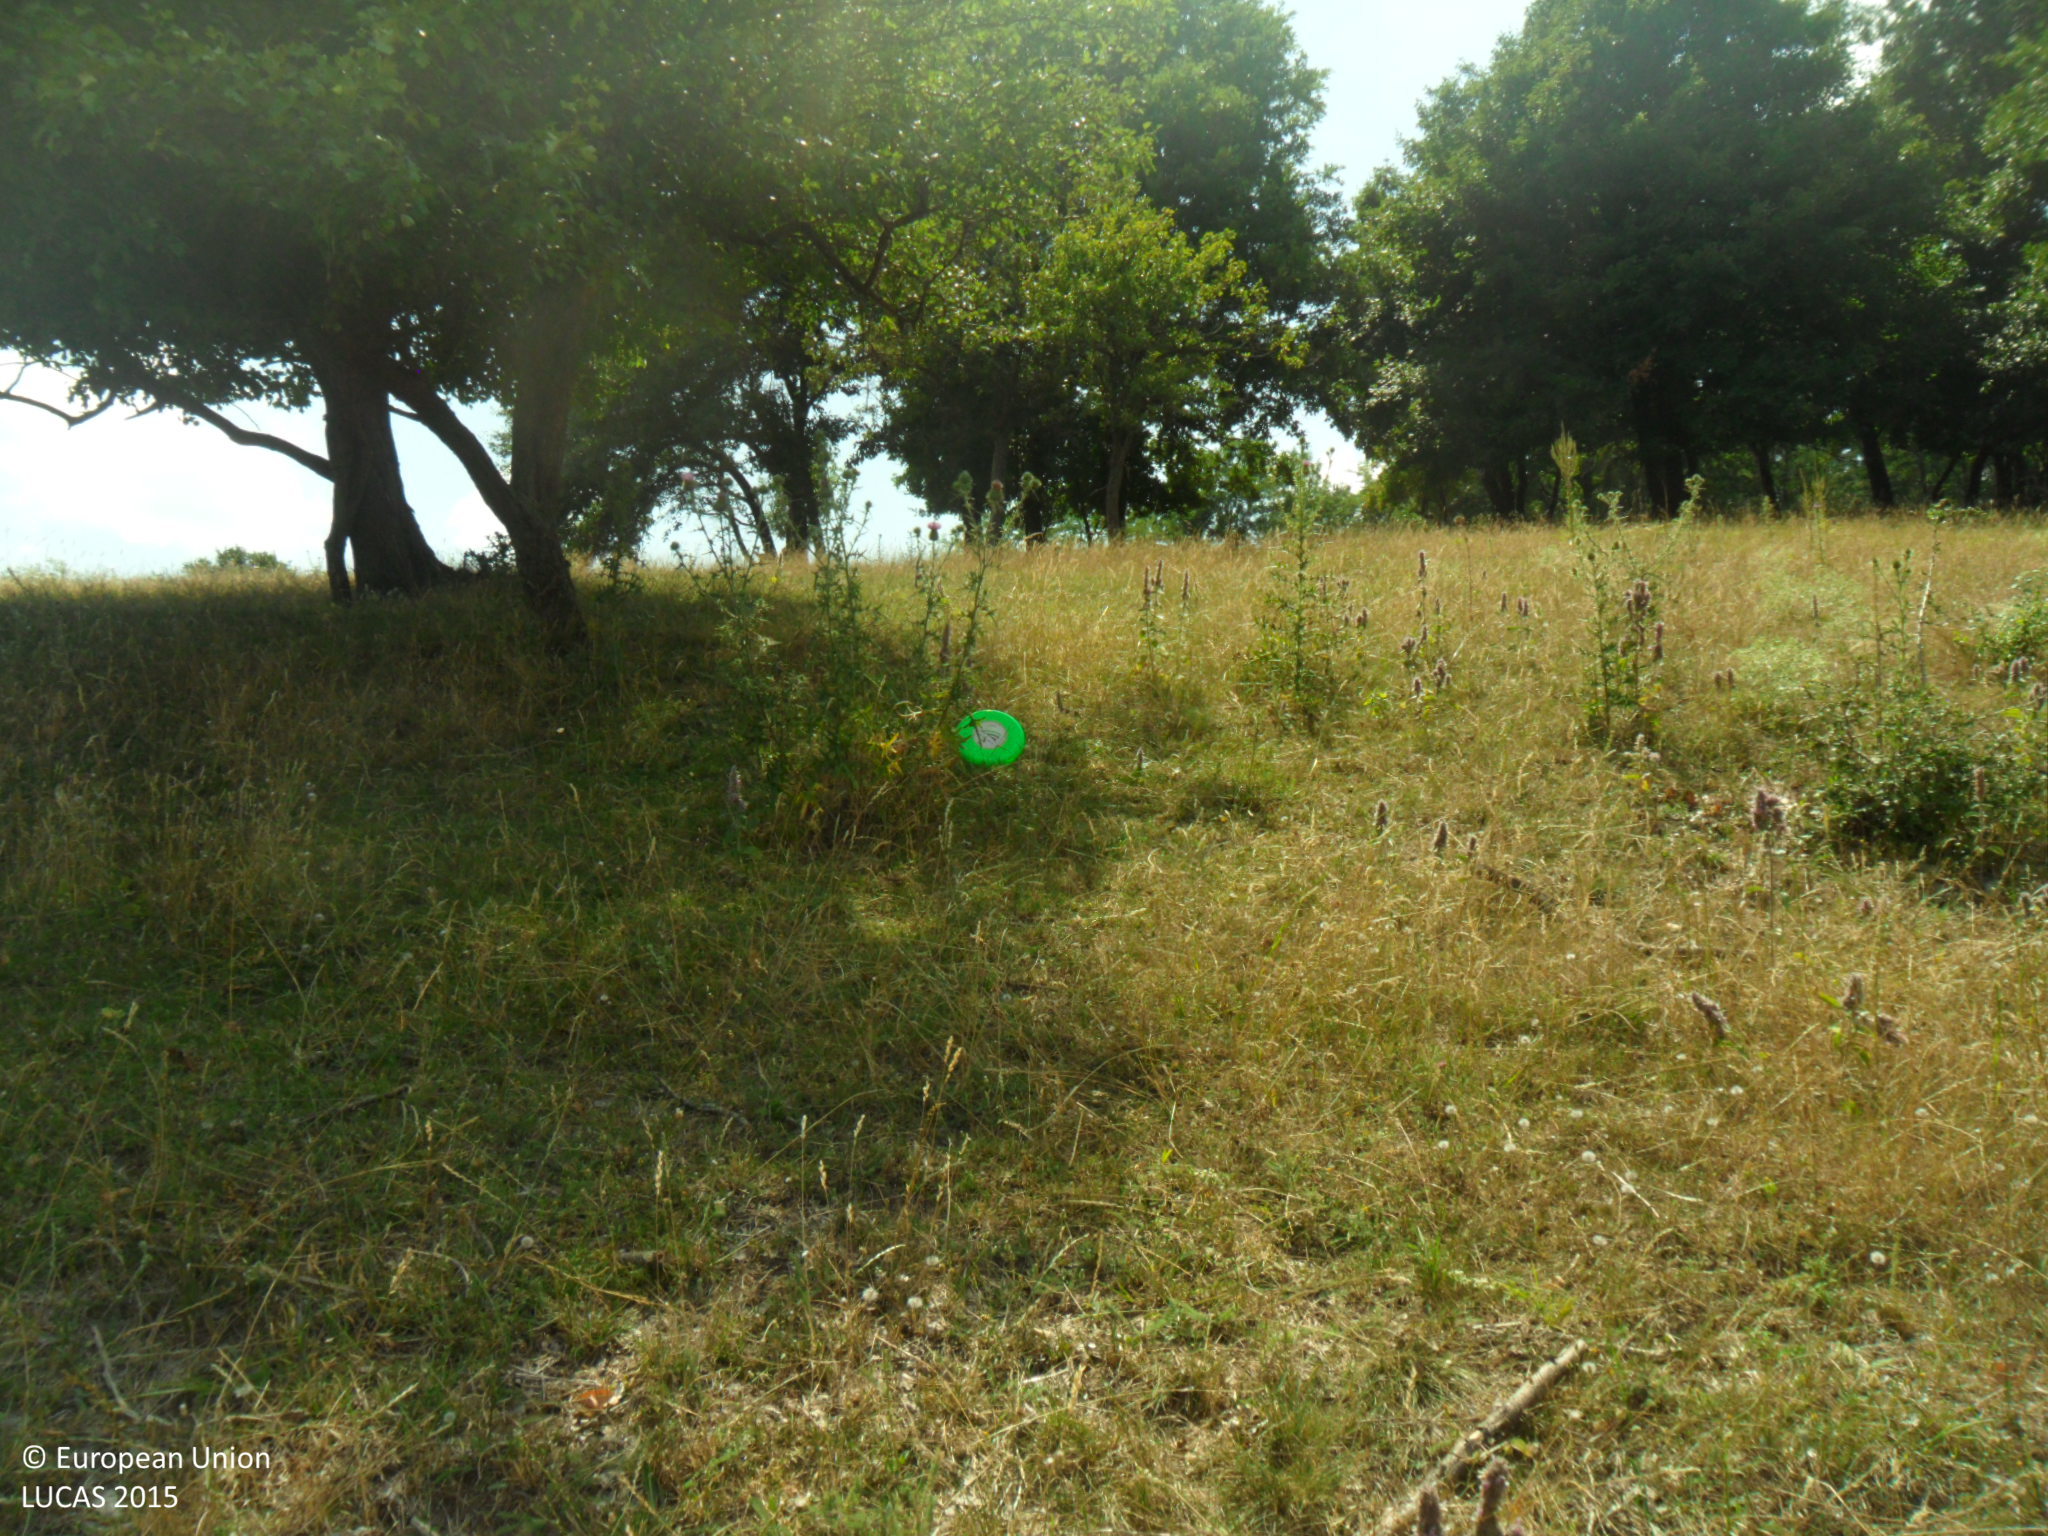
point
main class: Grassland
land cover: Grassland with sparse tree/shrub cover
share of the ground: > 75 %
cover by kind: herbaceous plants 90 %, broadleaved forest trees 5 %, shrubs 5 %
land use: Forestry
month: July
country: BG
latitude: 43.6438
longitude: 27.2714
